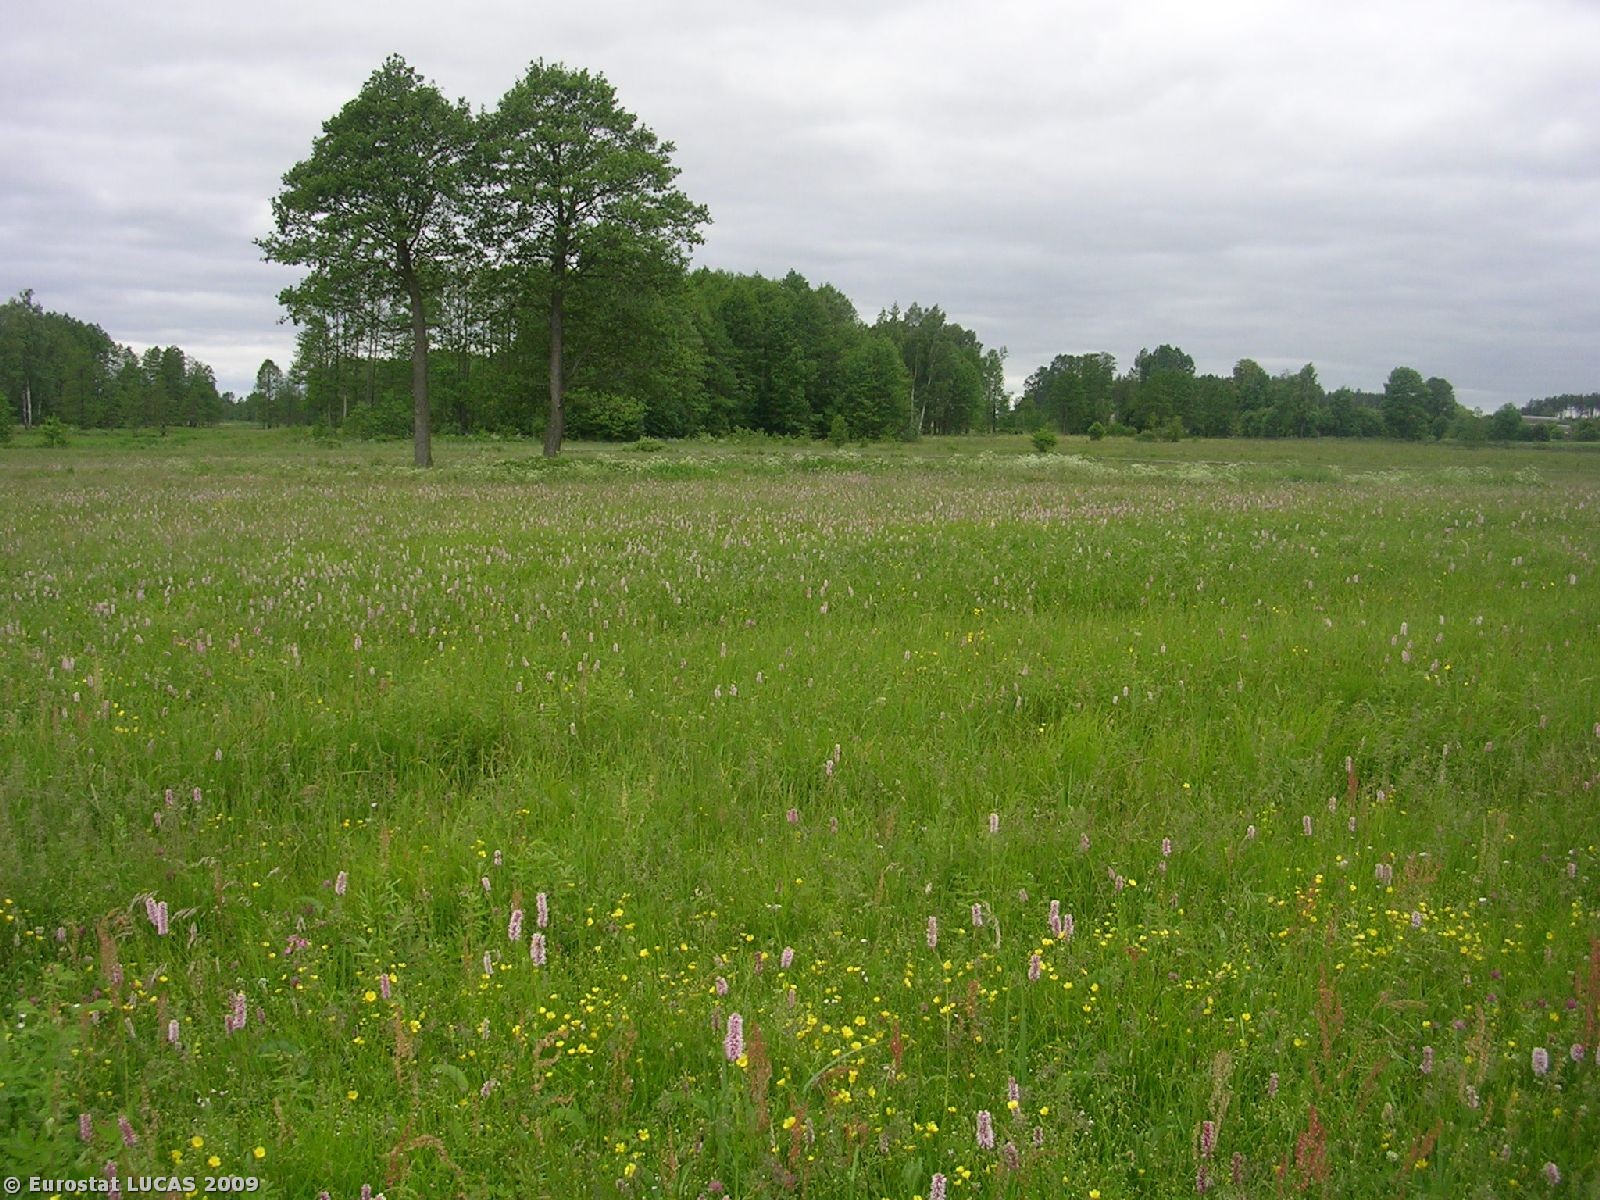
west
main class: Grassland
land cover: Grassland without tree/shrub cover
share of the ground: > 75 %
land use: Agriculture (excluding fallow land and kitchen gardens)
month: June
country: PL
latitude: 53.3804
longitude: 23.4165
